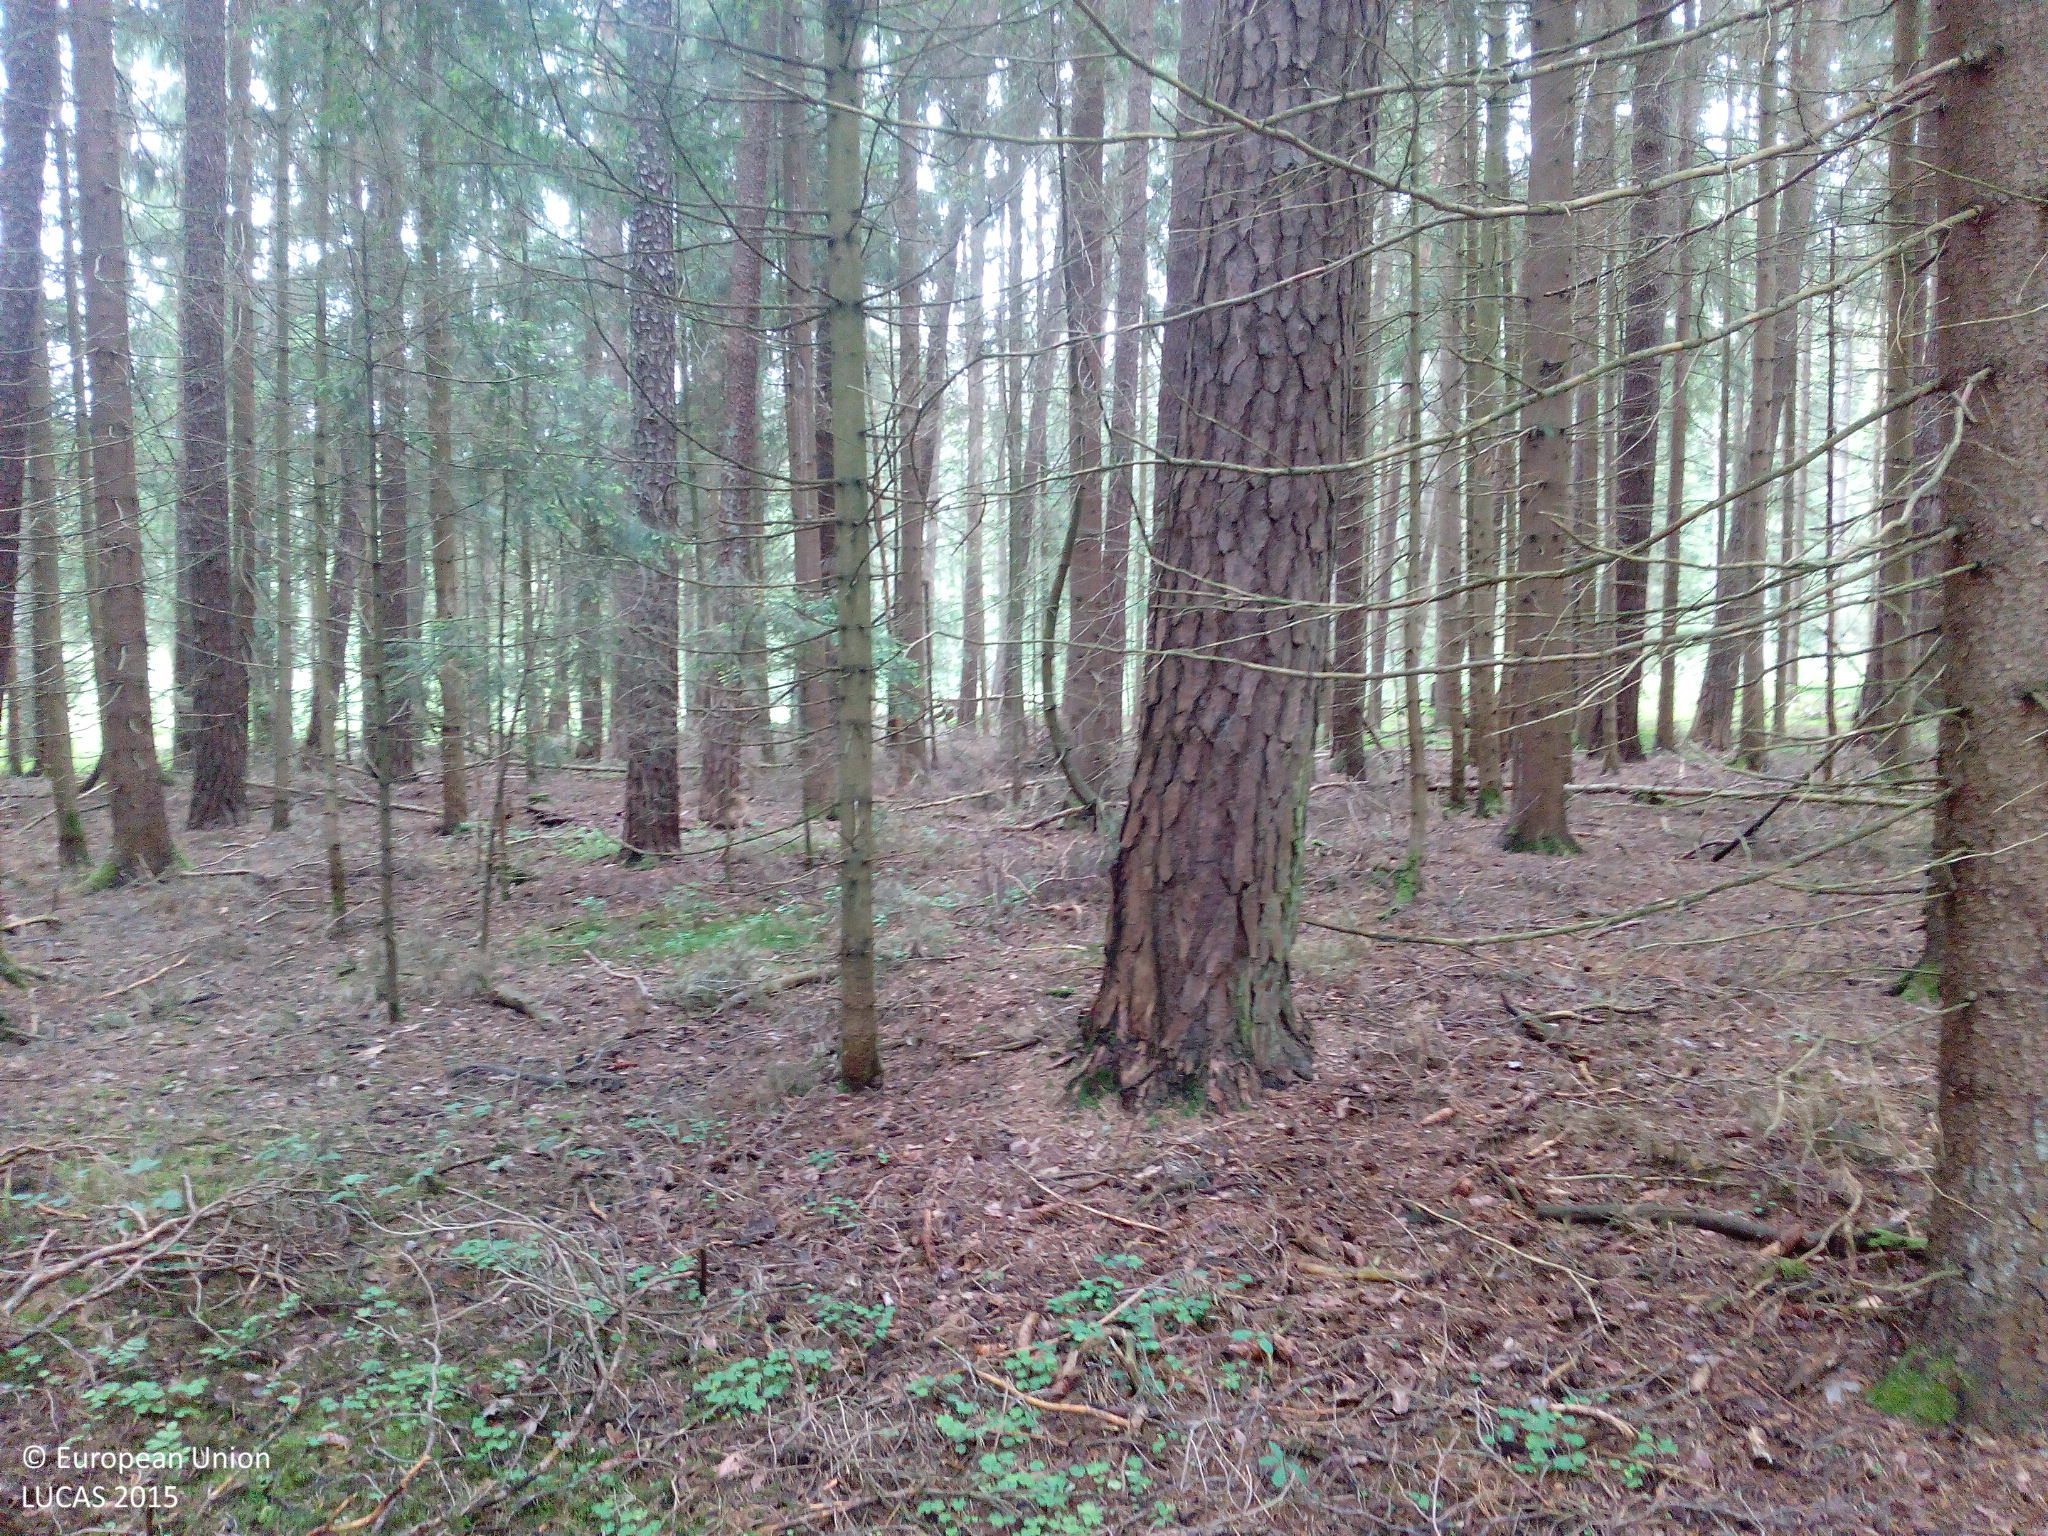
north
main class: Woodland
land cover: Other coniferous woodland
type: hemiboreal forest and nemoral coniferous forest and mixed broadleaved-coniferous forest
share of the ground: > 75 %
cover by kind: coniferous forest trees 80 %, lichens and mosses 10 %, unconsolidated bare surface 10 %
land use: Forestry
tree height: > 5 m
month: June
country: DE
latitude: 49.2964
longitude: 12.3509
